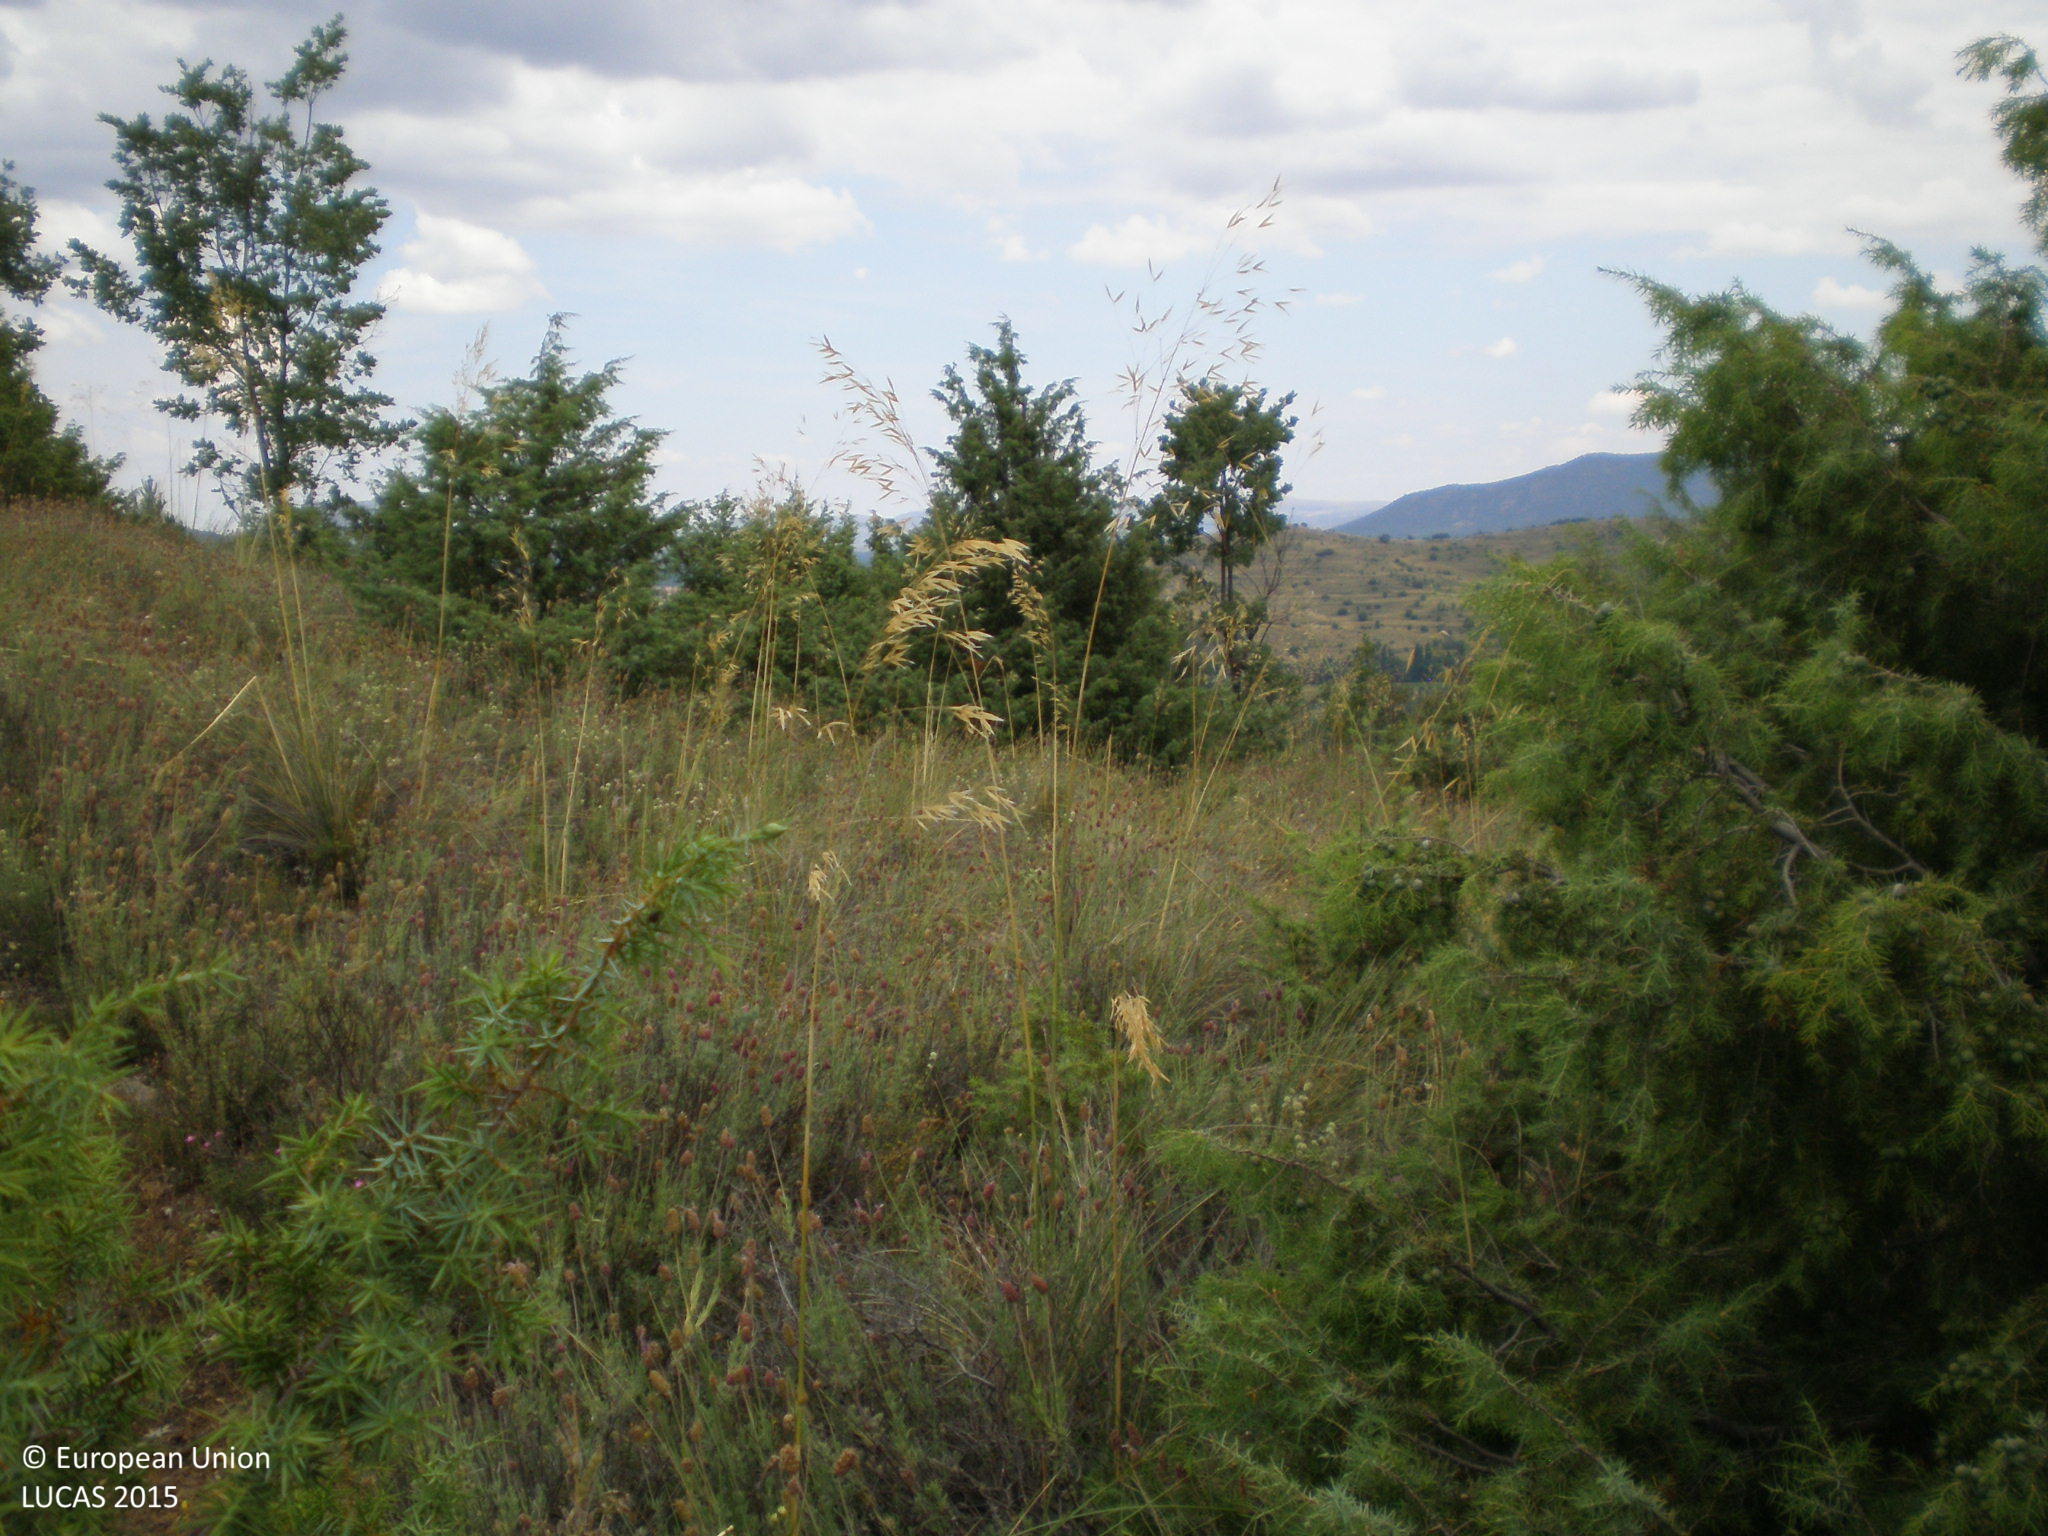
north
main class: Shrubland
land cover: Shrubland without tree cover
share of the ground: > 75 %
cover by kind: shrubs 100 %
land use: Semi-natural and natural areas not in use
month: June
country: ES
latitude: 40.3114
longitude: -5.5147
